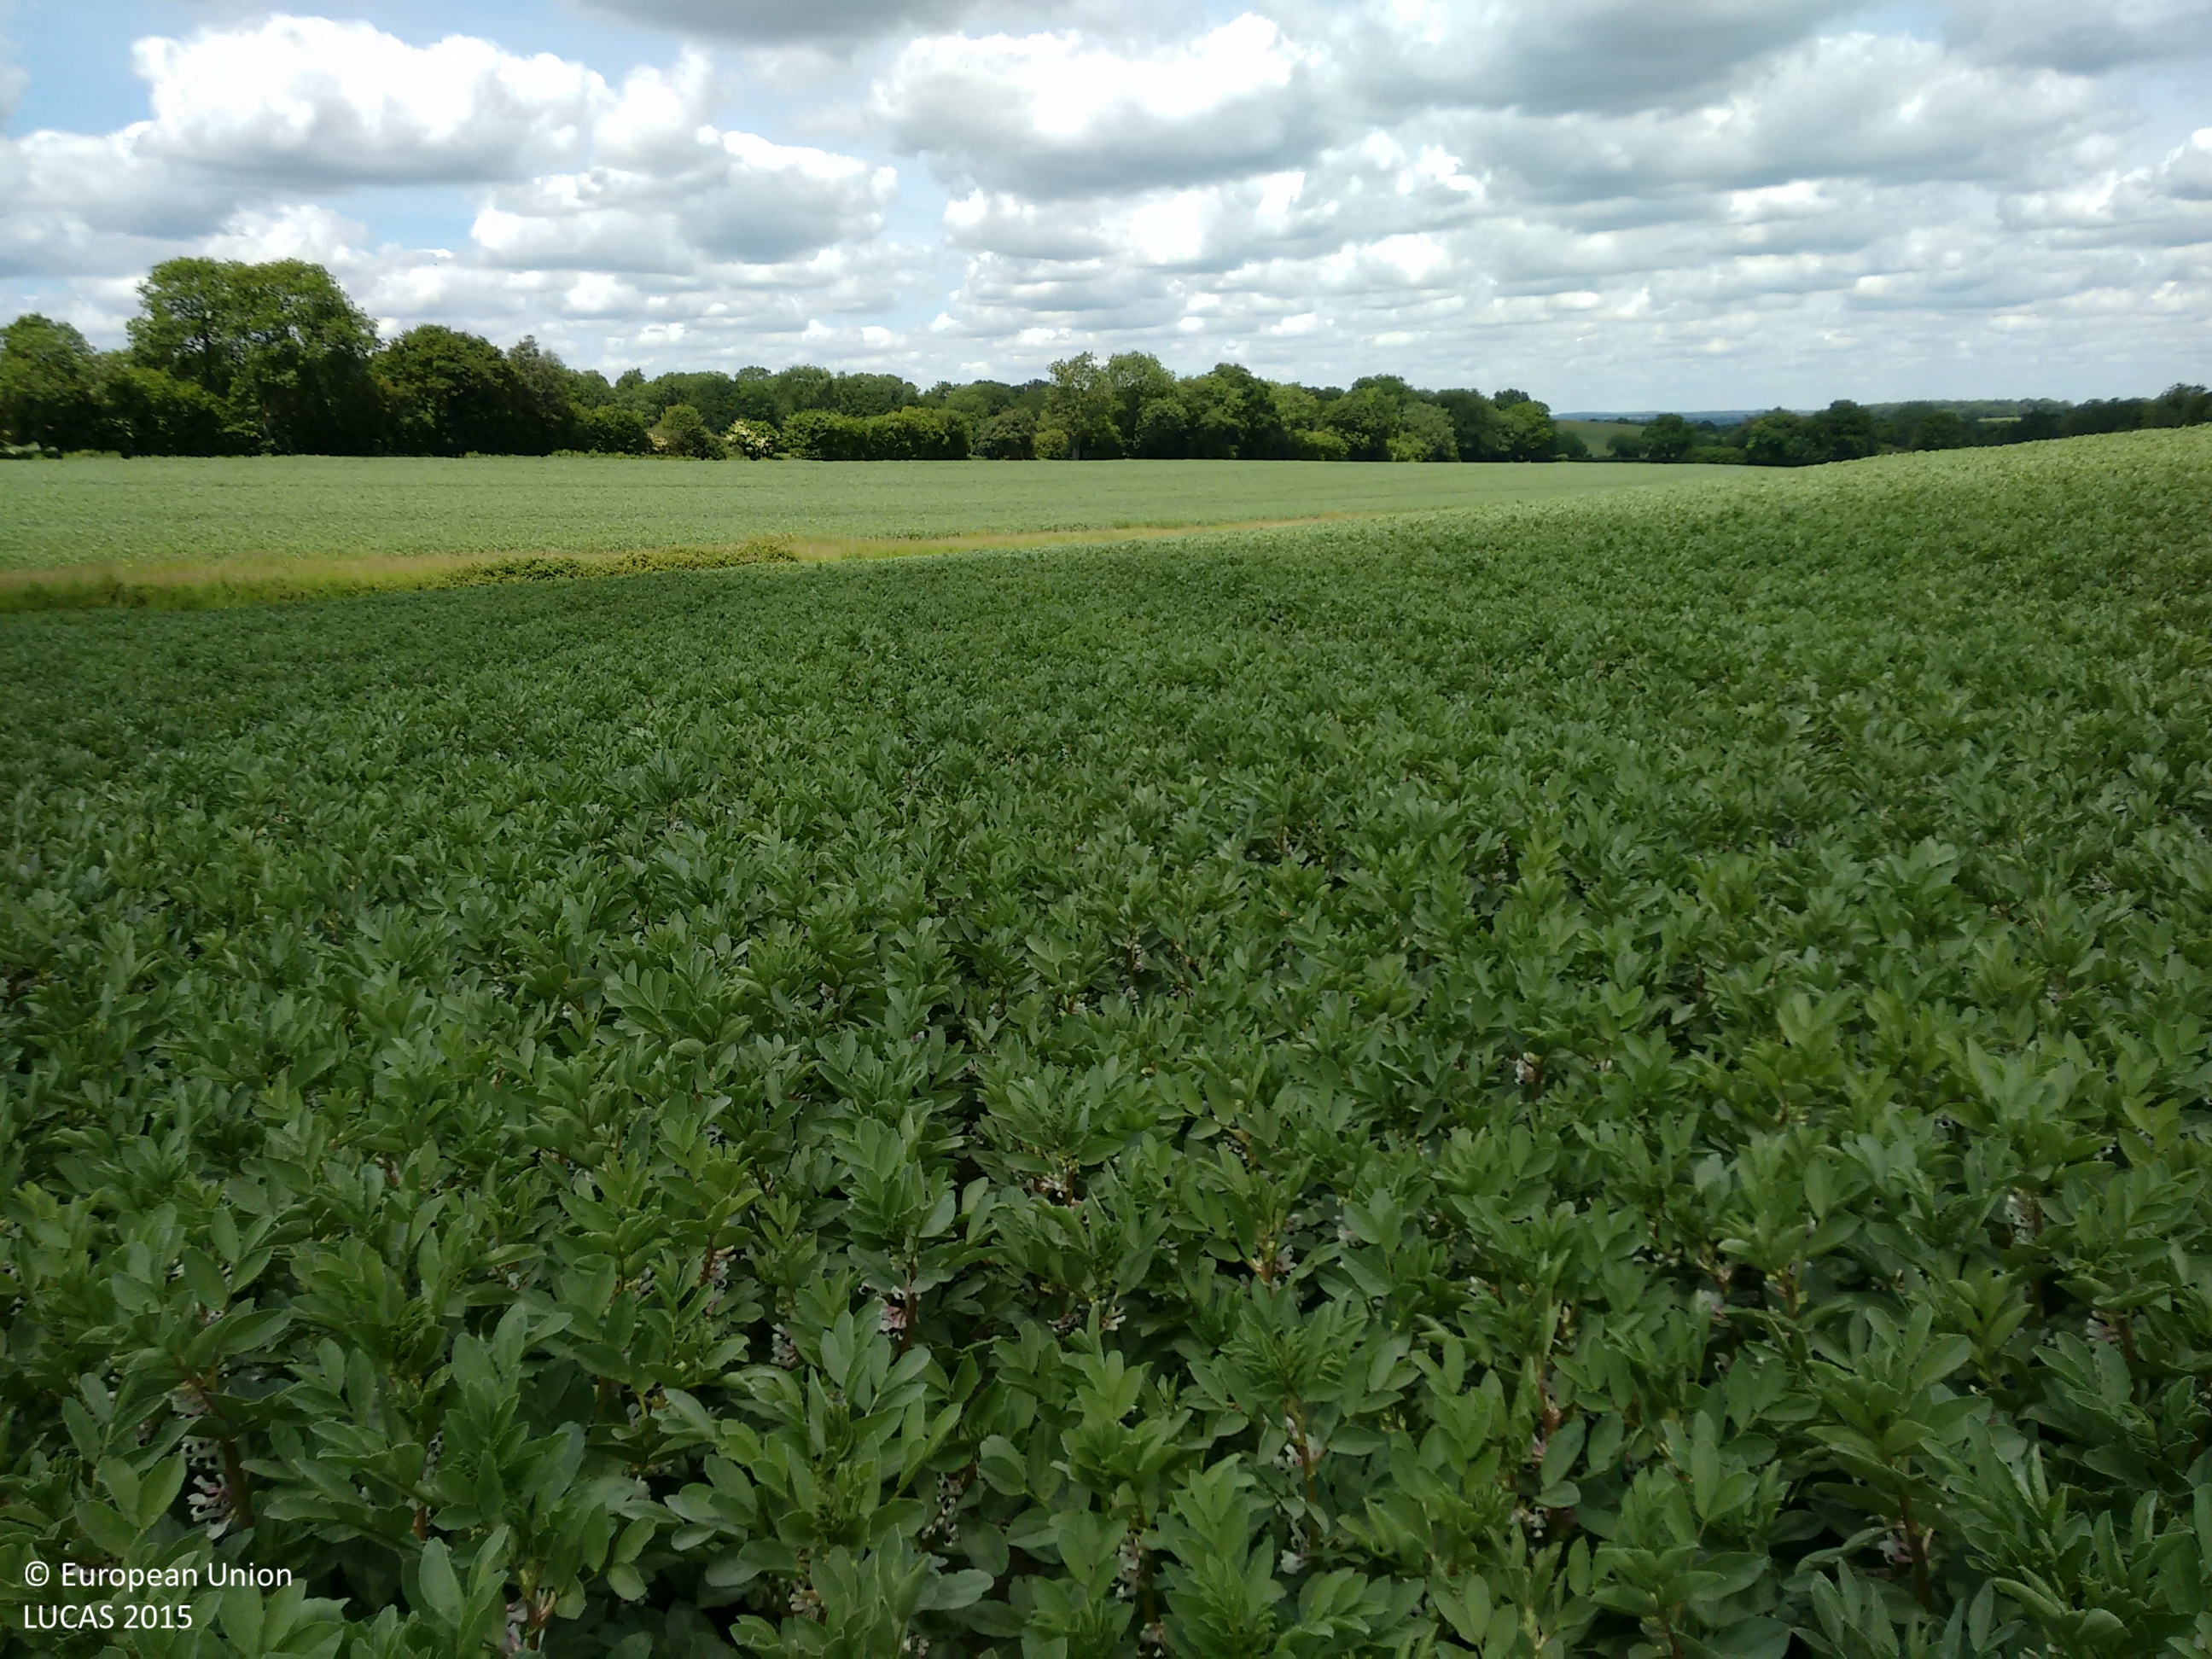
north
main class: Cropland
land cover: Dry pulses
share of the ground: > 75 %
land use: Agriculture (excluding fallow land and kitchen gardens)
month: June
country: GB
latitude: 51.3625
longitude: -1.4978
